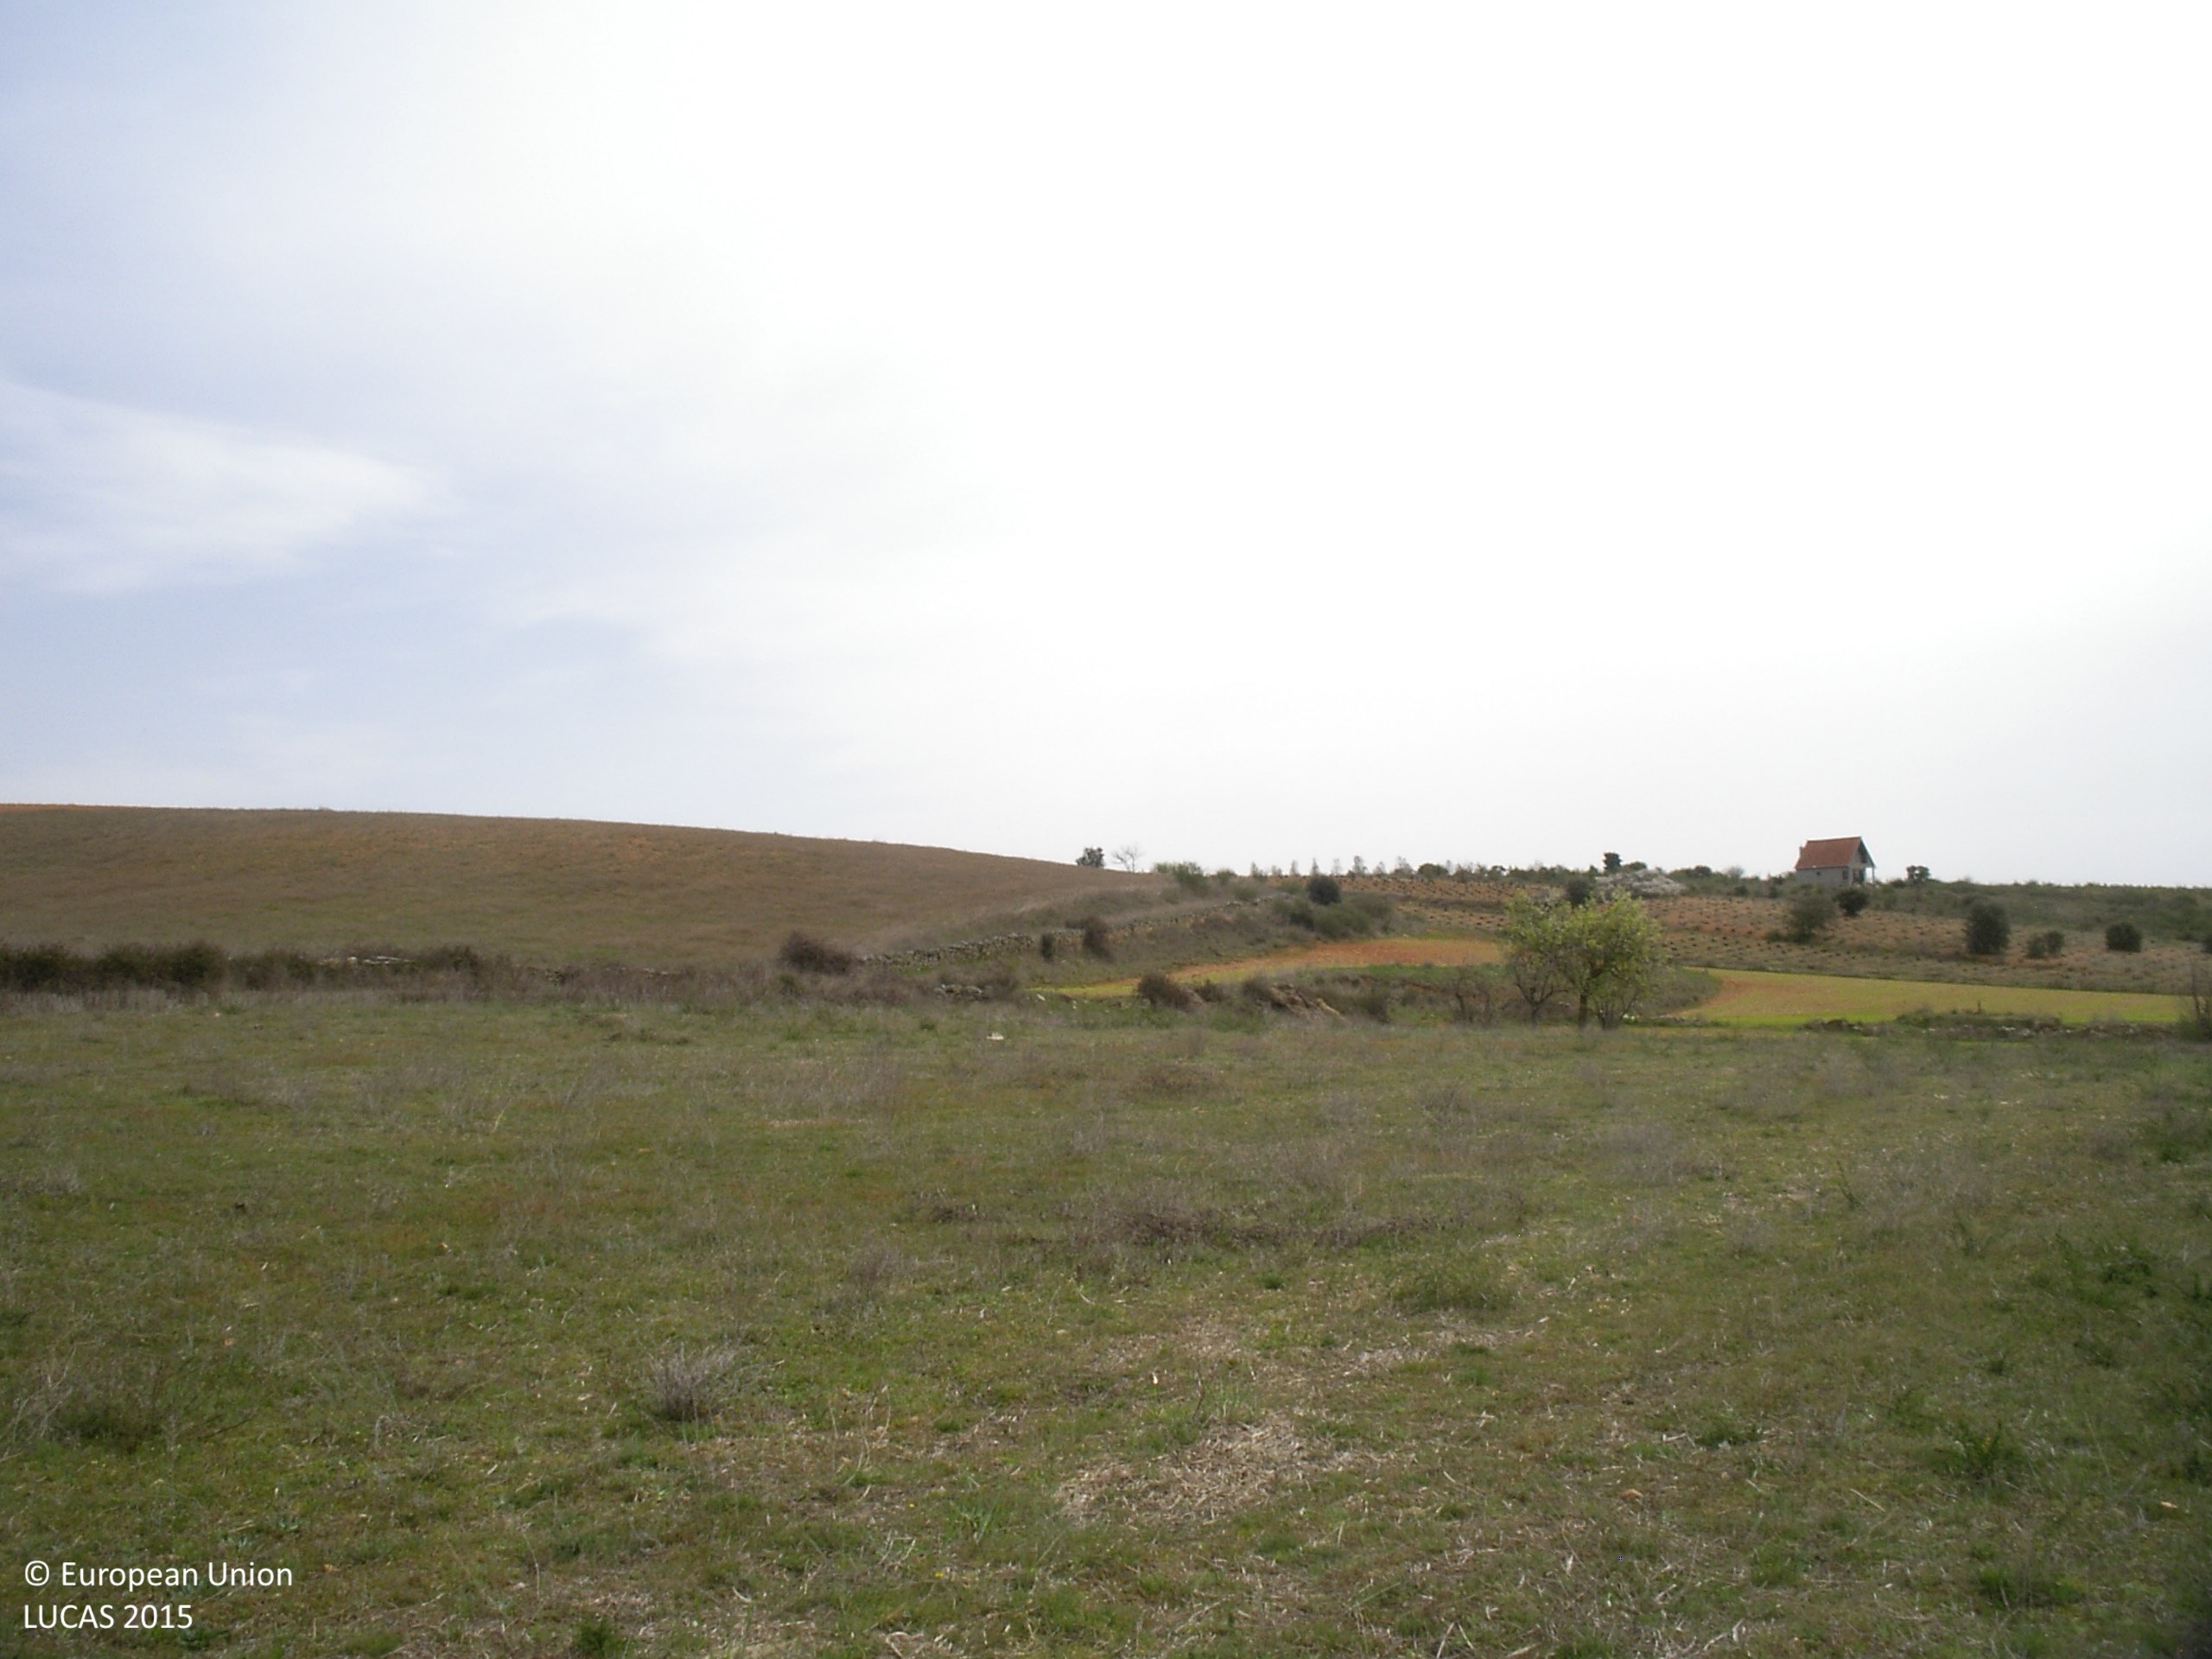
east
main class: Grassland
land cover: Grassland with sparse tree/shrub cover
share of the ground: > 75 %
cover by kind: herbaceous plants 90 %, coniferous forest trees 5 %, shrubs 5 %
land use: Agriculture (excluding fallow land and kitchen gardens)
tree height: < 5 m
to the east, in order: Grassland with sparse tree/shrub cover; Shruby margins; Dry stone walls; Grass margins; Durum wheat; Grass margins; Dry stone walls; Grass margins; Tracks; Spontaneously vegetated surfaces; Shrubland without tree cover; Grassland with sparse tree/shrub cover; Tracks
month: April
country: ES
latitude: 42.4201
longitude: -6.1122
